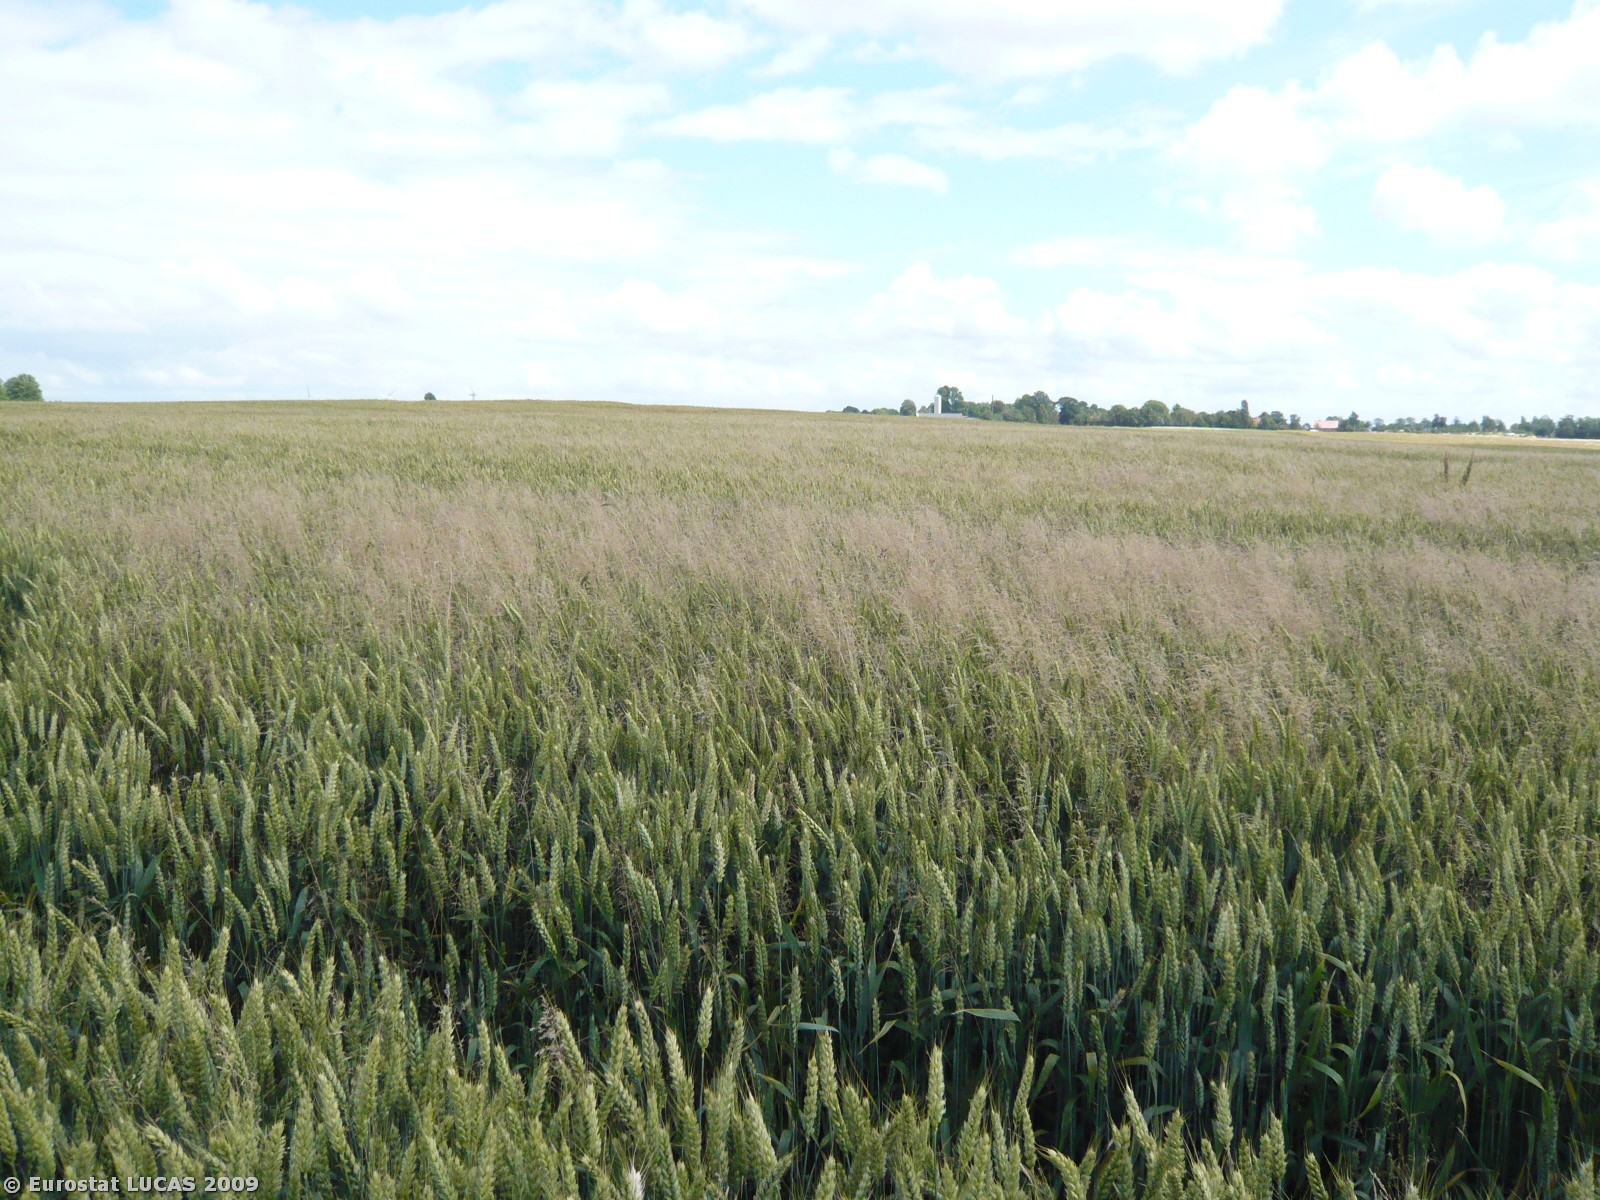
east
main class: Cropland
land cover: Common wheat
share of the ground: > 75 %
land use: Agriculture (excluding fallow land and kitchen gardens)
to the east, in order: Common wheat
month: July
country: DK
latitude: 55.6612
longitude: 11.1593
